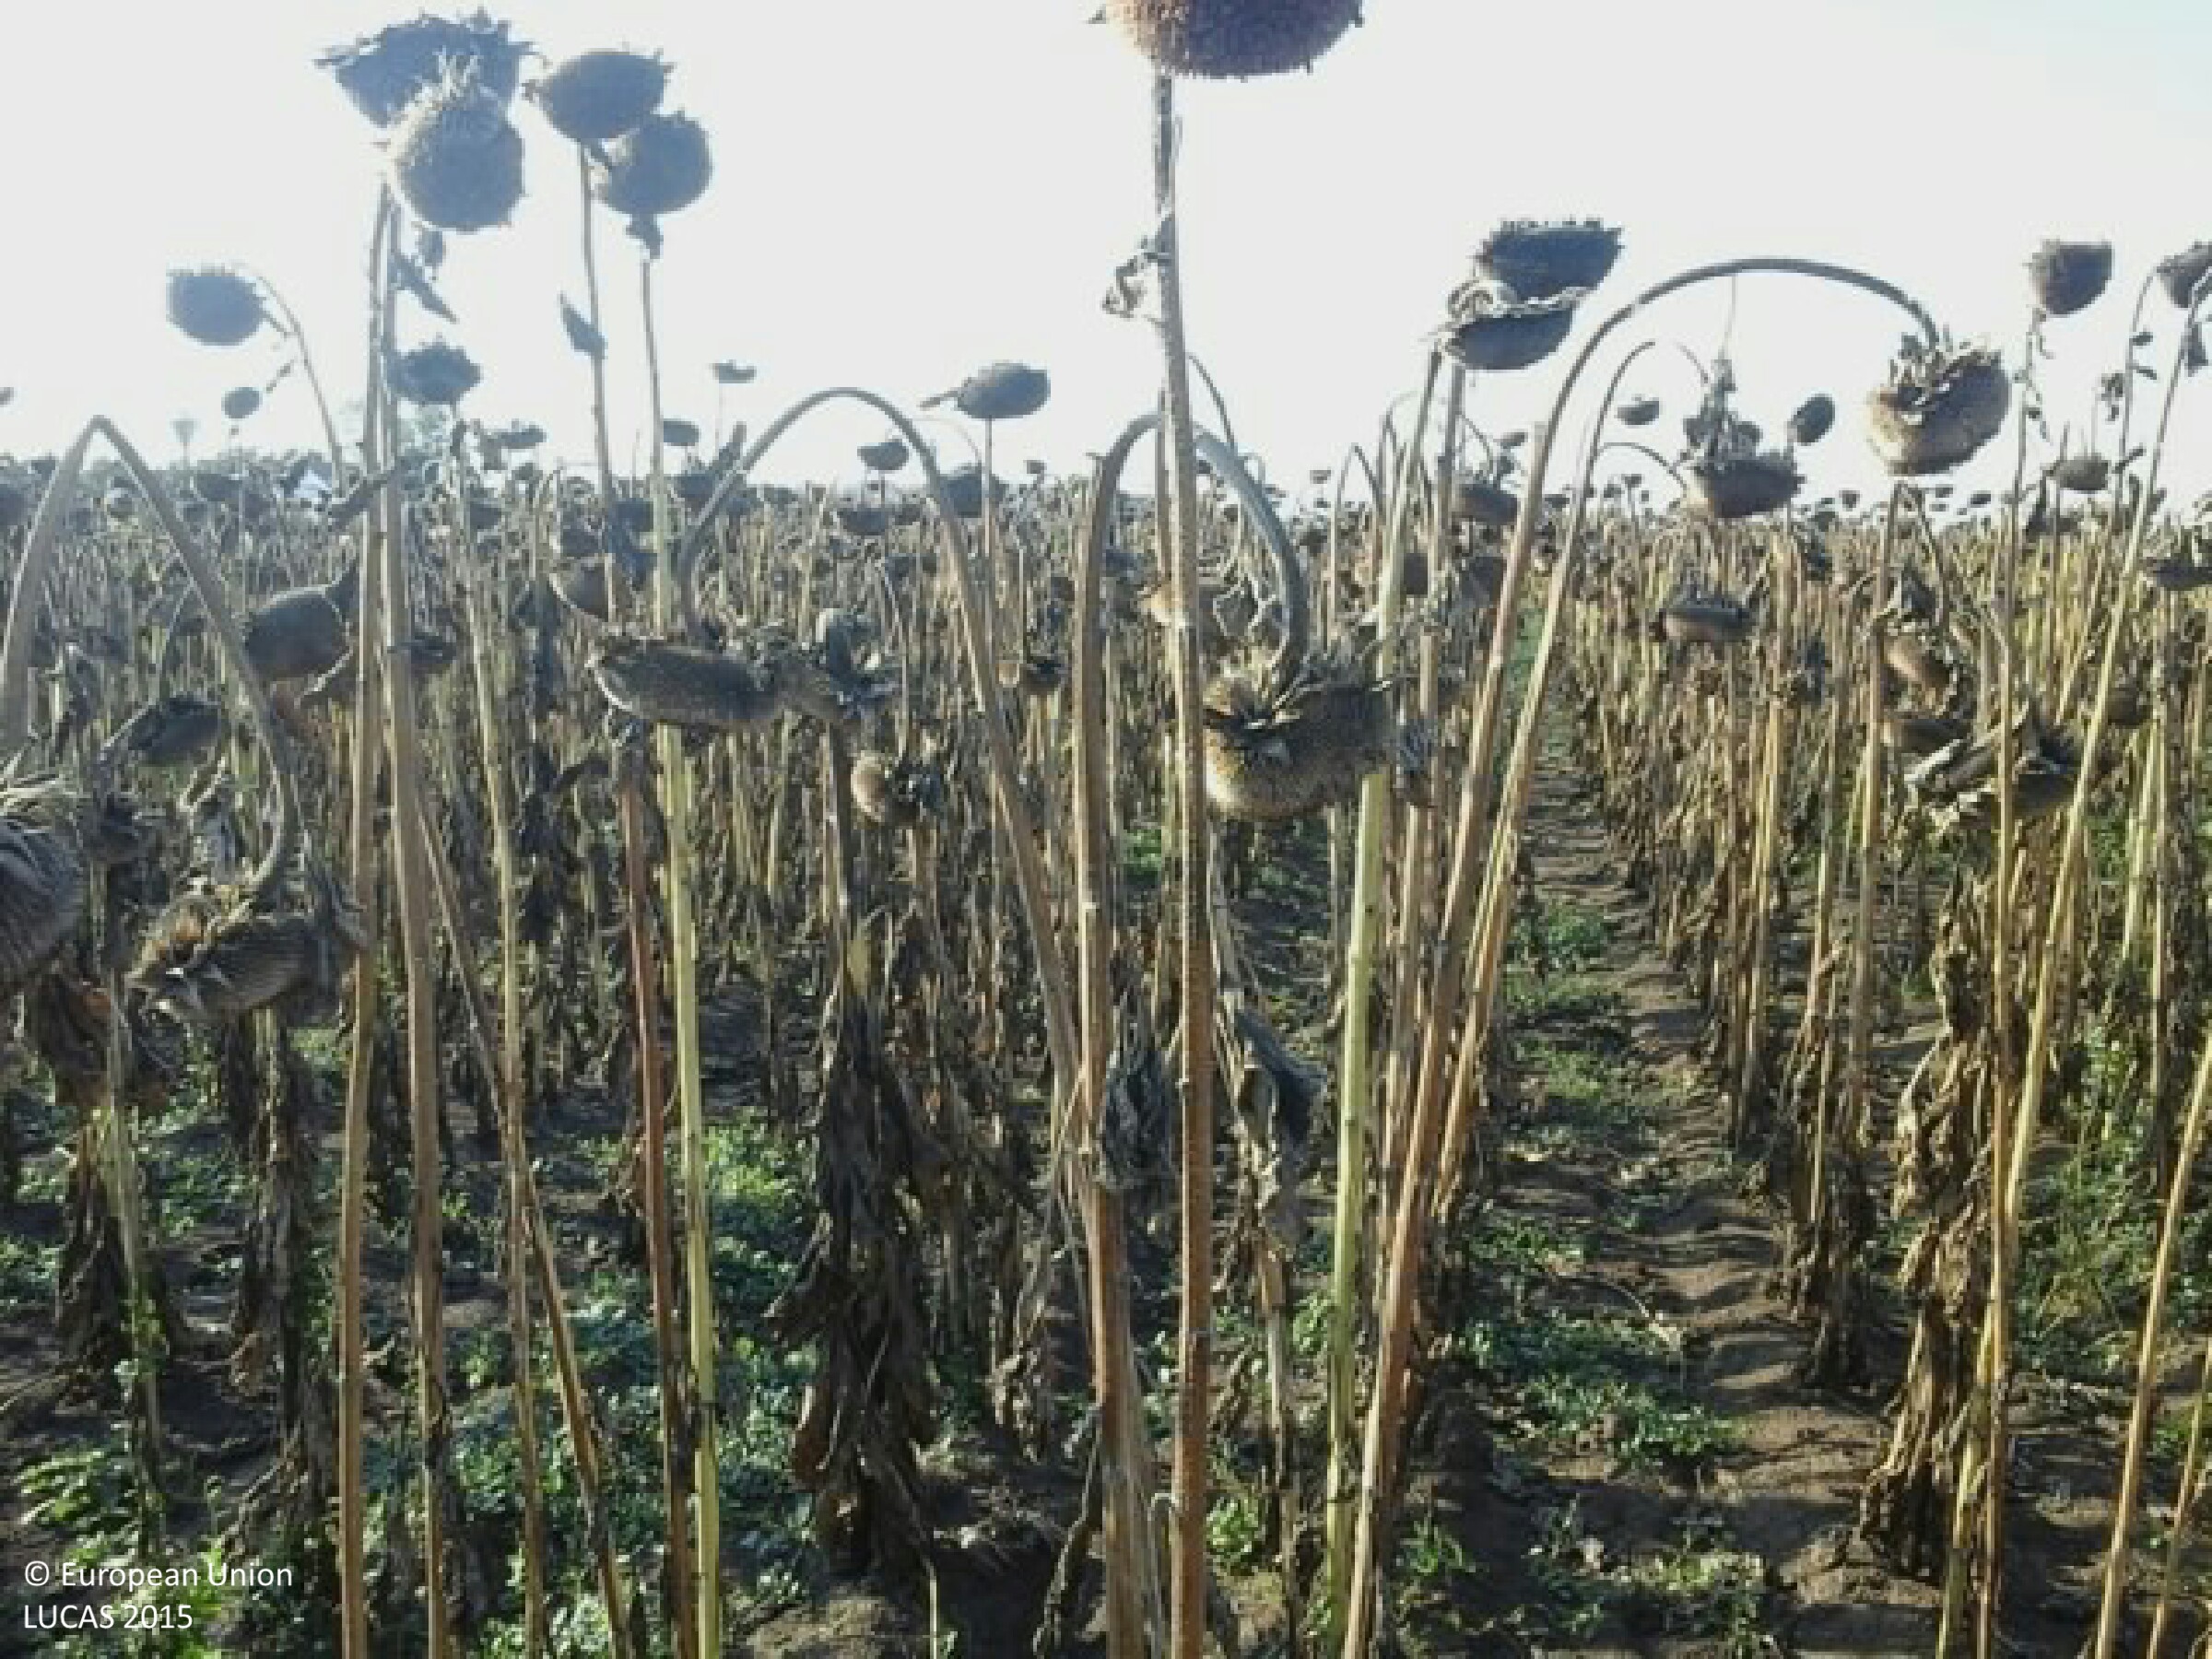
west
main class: Cropland
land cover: Sunflower
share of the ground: 50 - 75 %
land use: Agriculture (excluding fallow land and kitchen gardens)
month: September
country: HU
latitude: 47.6556
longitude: 19.8378
